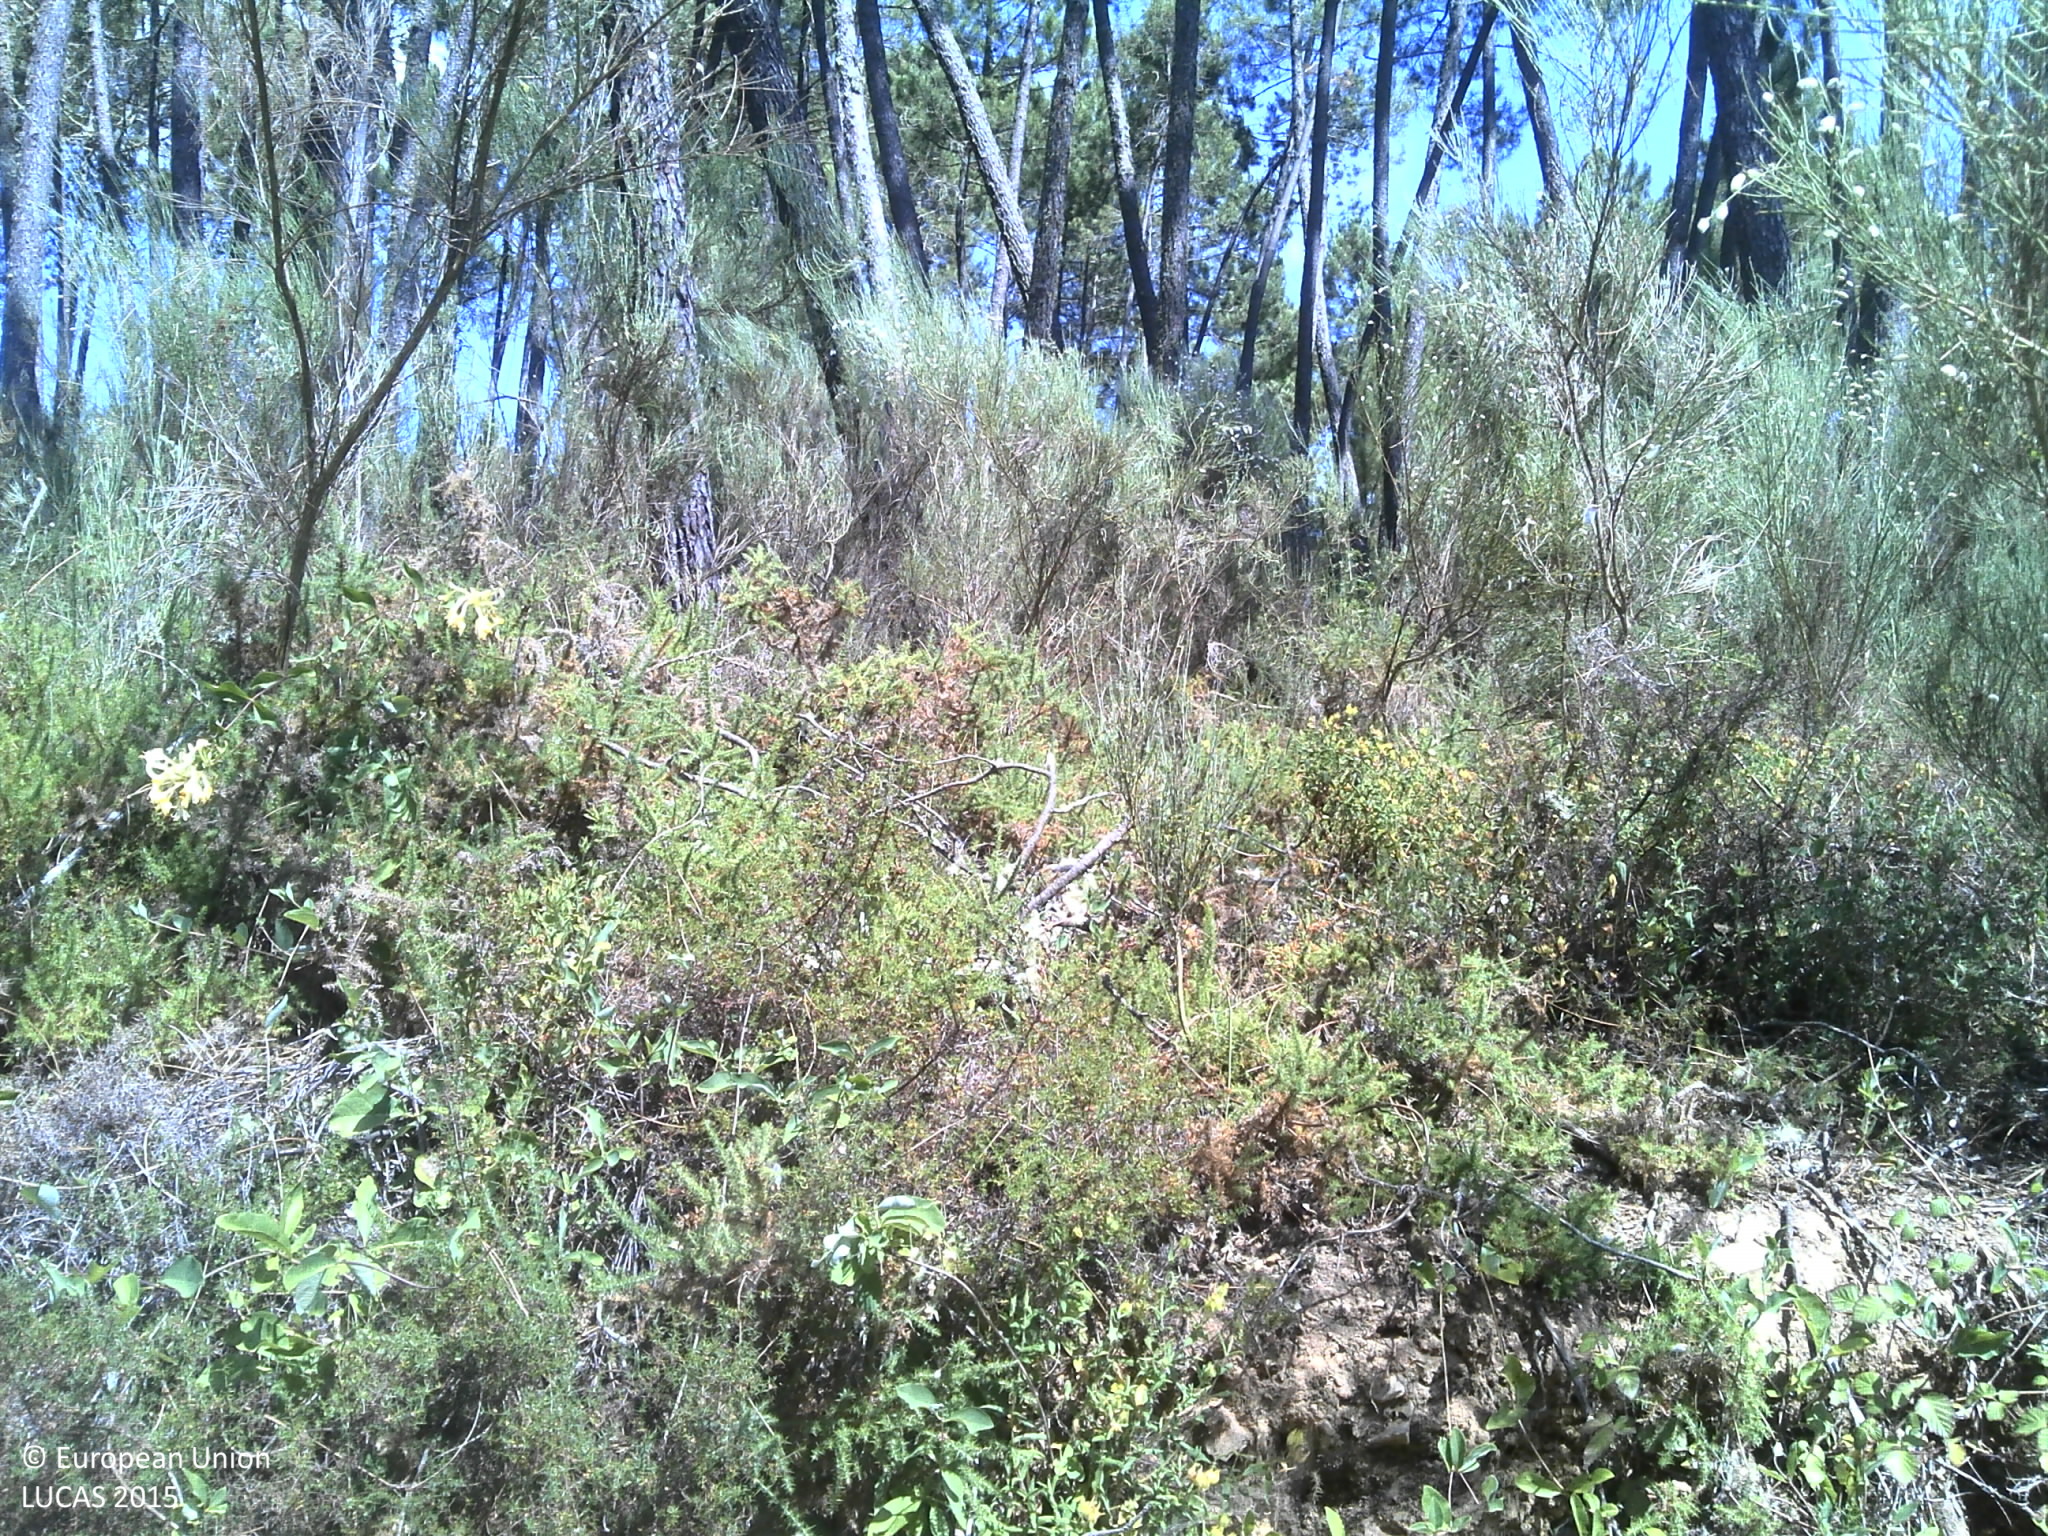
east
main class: Woodland
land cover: Pine dominated coniferous woodland
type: coniferous forest of the mediterranean region
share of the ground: 25 - 50 %
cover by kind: coniferous forest trees 50 %, shrubs 35 %, unconsolidated bare surface 15 %
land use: Forestry
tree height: > 5 m
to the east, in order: Pine dominated coniferous woodland; Shrubland with sparse tree cover; Tracks; Pine dominated coniferous woodland; Fences; Grassland without tree/shrub cover; Fences; Pine dominated coniferous woodland
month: July
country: PT
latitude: 39.9645
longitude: -7.8469
